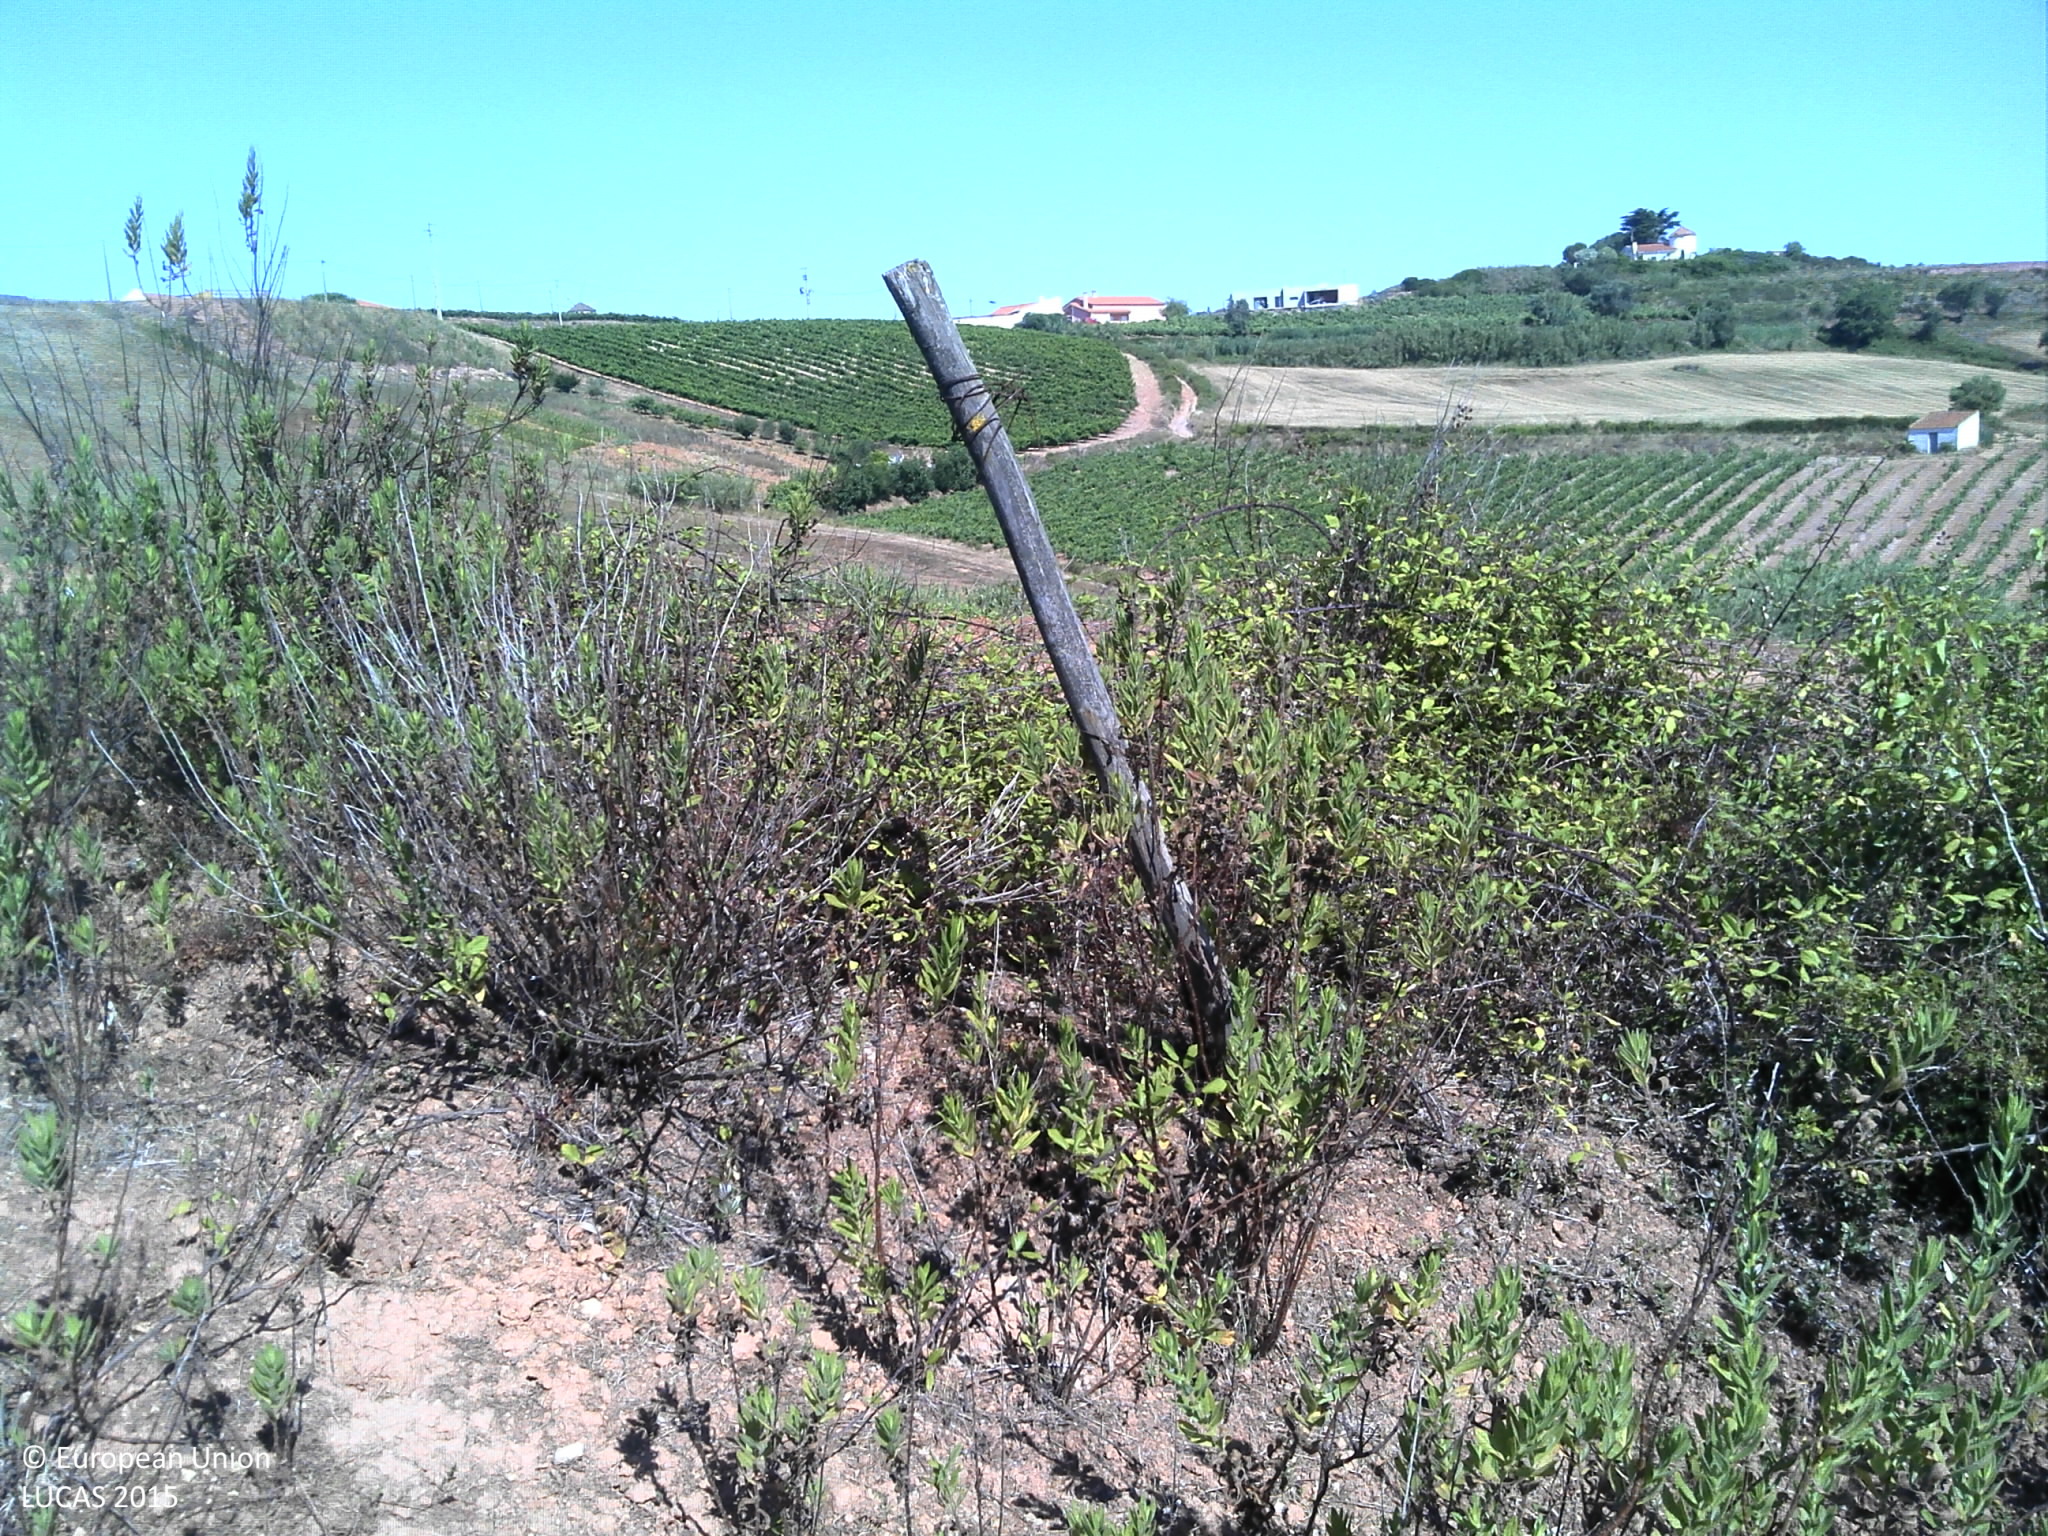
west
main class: Shrubland
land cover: Shrubland without tree cover
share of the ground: 50 - 75 %
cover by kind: shrubs 60 %, unconsolidated bare surface 30 %, herbaceous plants 10 %
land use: Semi-natural and natural areas not in use
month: June
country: PT
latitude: 39.0269
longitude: -9.2478
